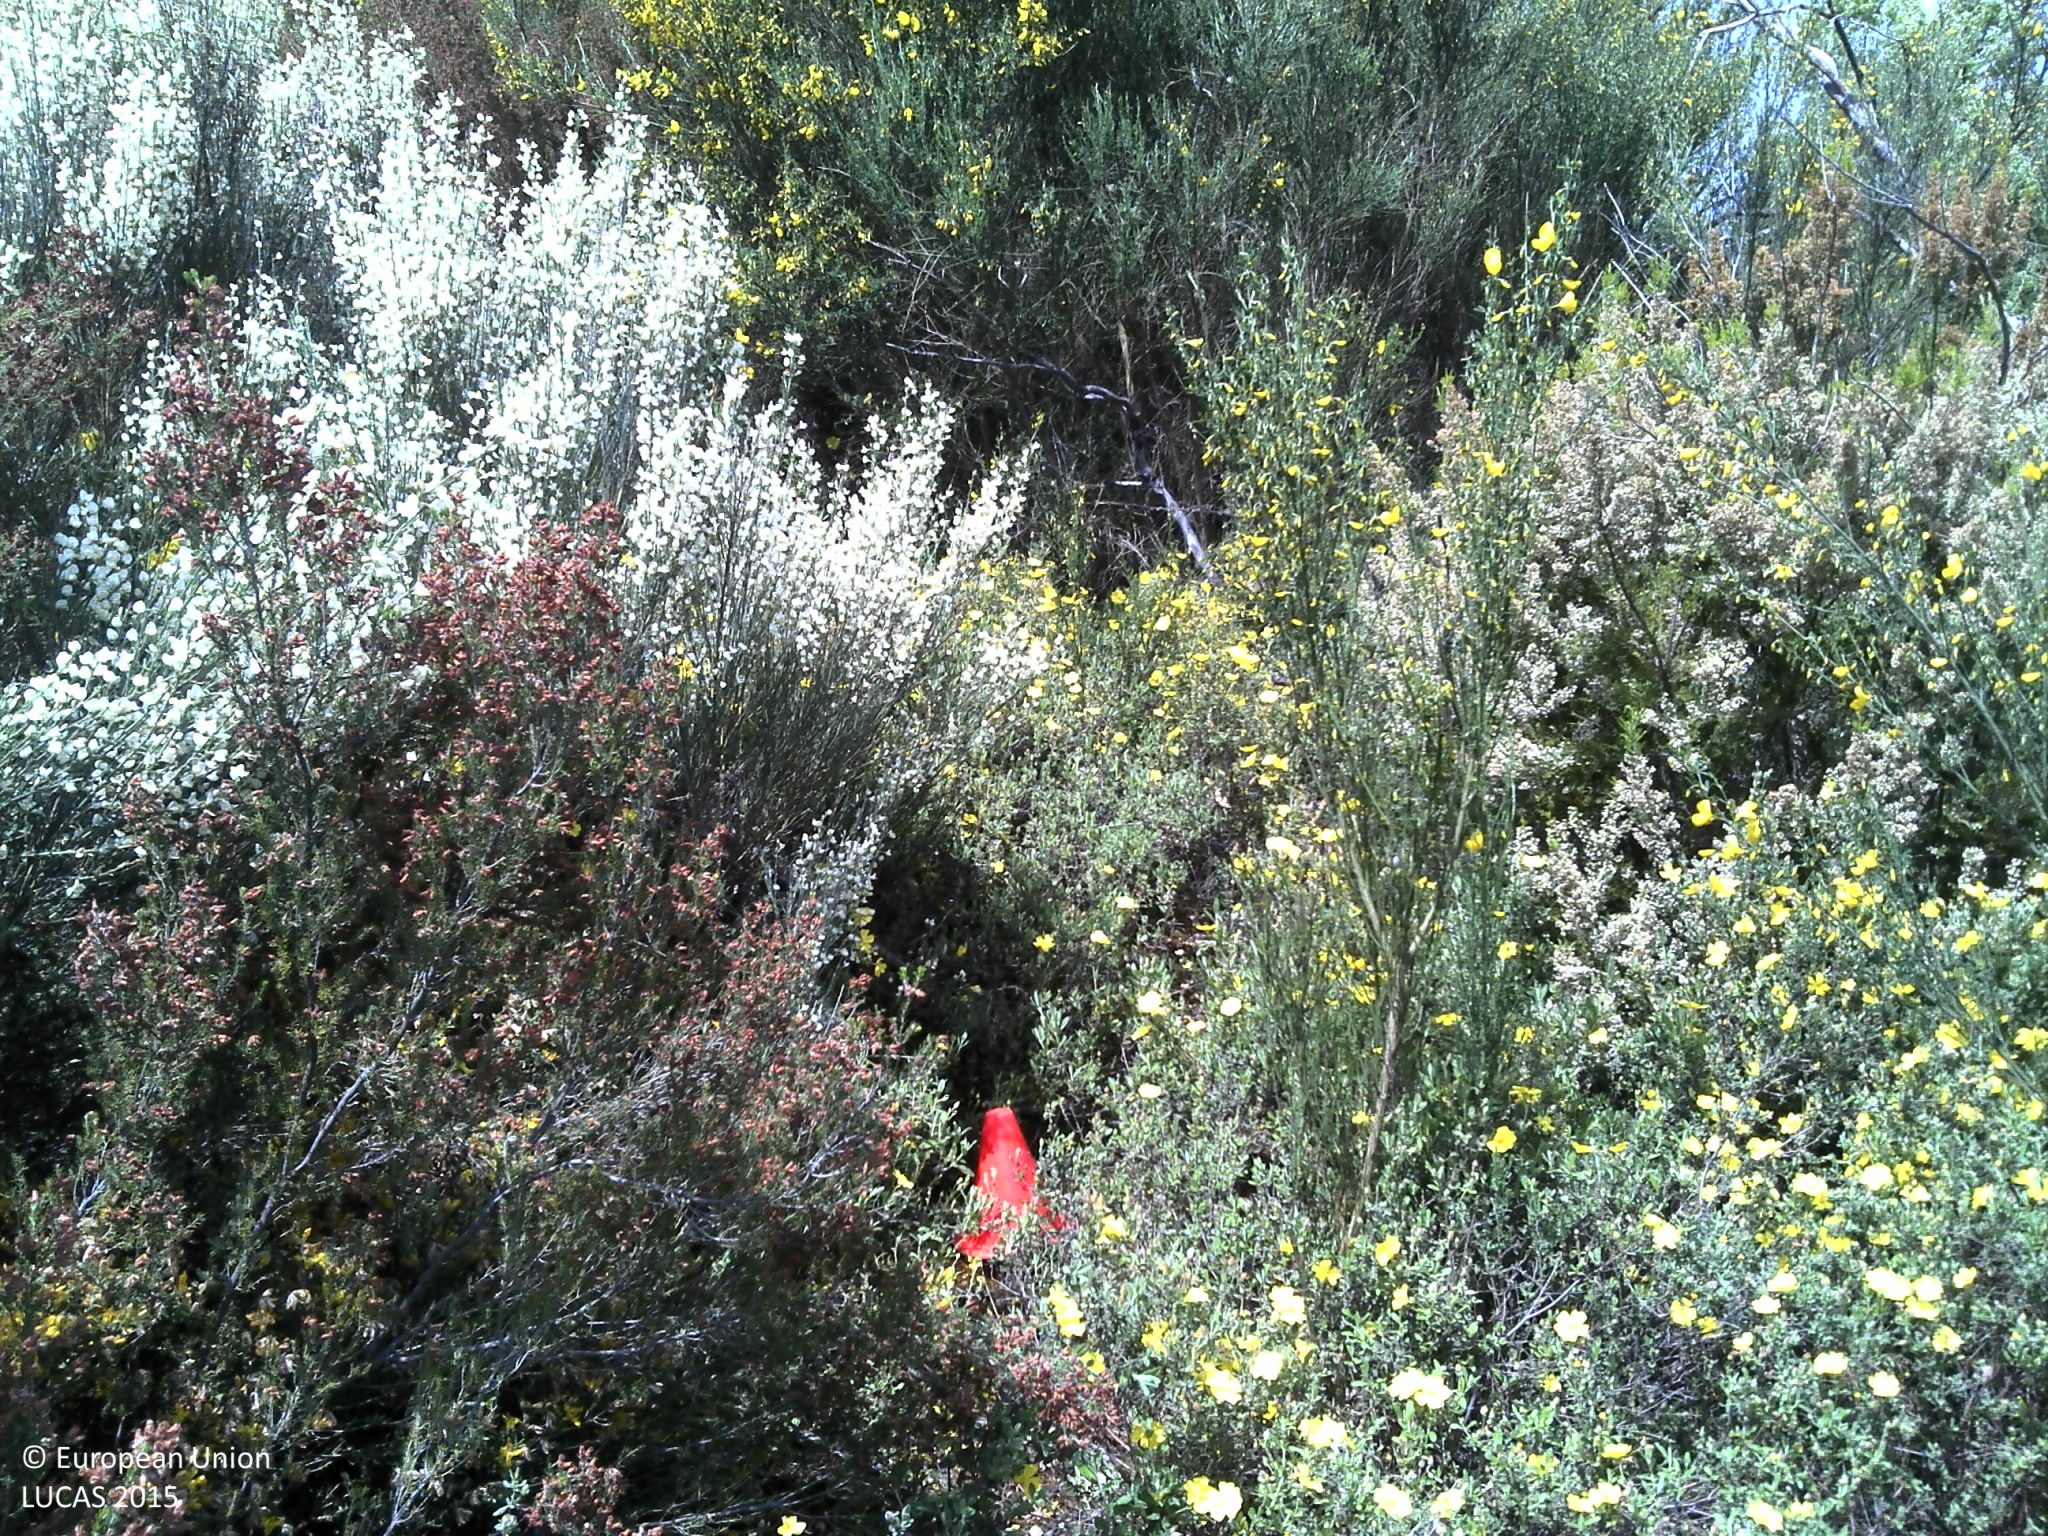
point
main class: Shrubland
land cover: Shrubland with sparse tree cover
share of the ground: > 75 %
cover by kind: shrubs 85 %, herbaceous plants 10 %, broadleaved forest trees 5 %
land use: Forestry
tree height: < 5 m
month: May
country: PT
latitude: 41.9338
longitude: -7.0426
